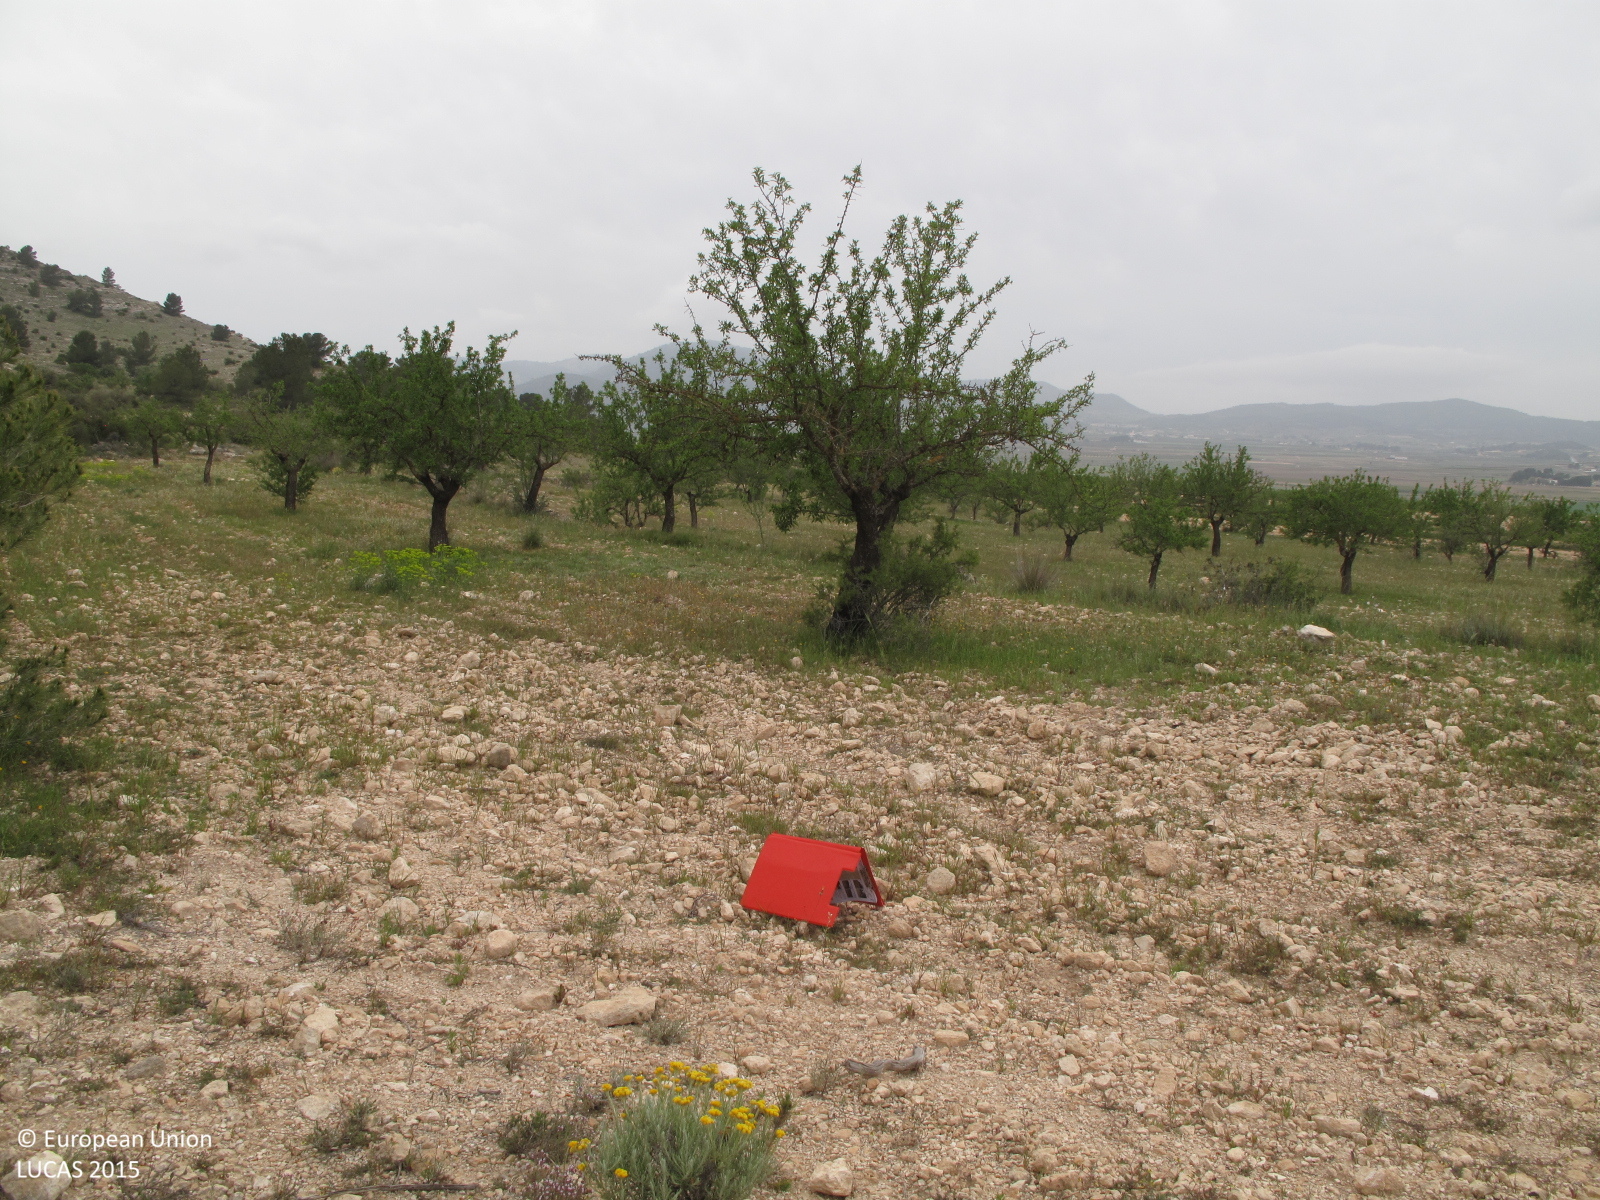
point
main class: Cropland
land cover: Nuts trees
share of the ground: < 10 %
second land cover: Spontaneously vegetated surfaces
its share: > 75 %
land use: Agriculture (excluding fallow land and kitchen gardens)
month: April
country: ES
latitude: 38.4344
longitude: -0.9057
